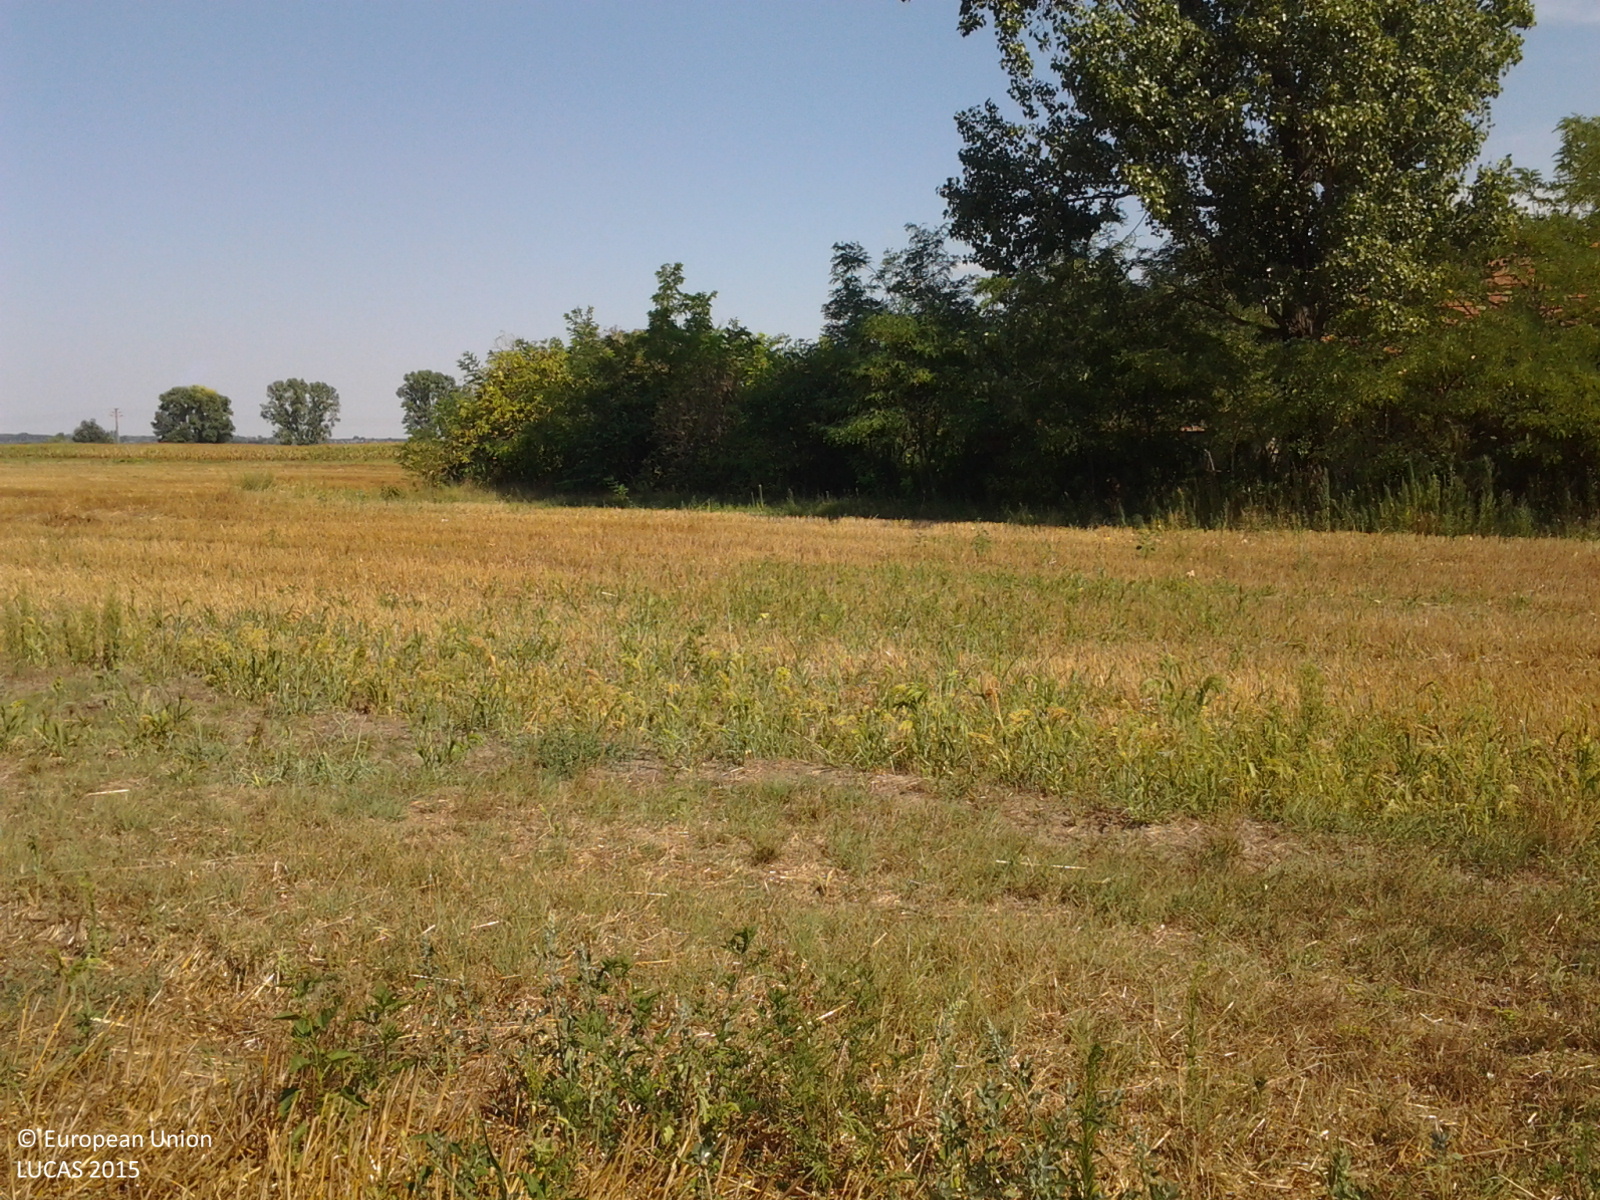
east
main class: Cropland
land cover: Triticale
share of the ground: > 75 %
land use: Agriculture (excluding fallow land and kitchen gardens)
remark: Harvested field
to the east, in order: Triticale; Grass margins; Tracks; Grass margins; Triticale; Grass margins; Broadleaved woodland; Shruby margins; Triticale; Grassland without tree/shrub cover; Maize
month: August
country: HU
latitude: 47.3681
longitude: 19.8096
